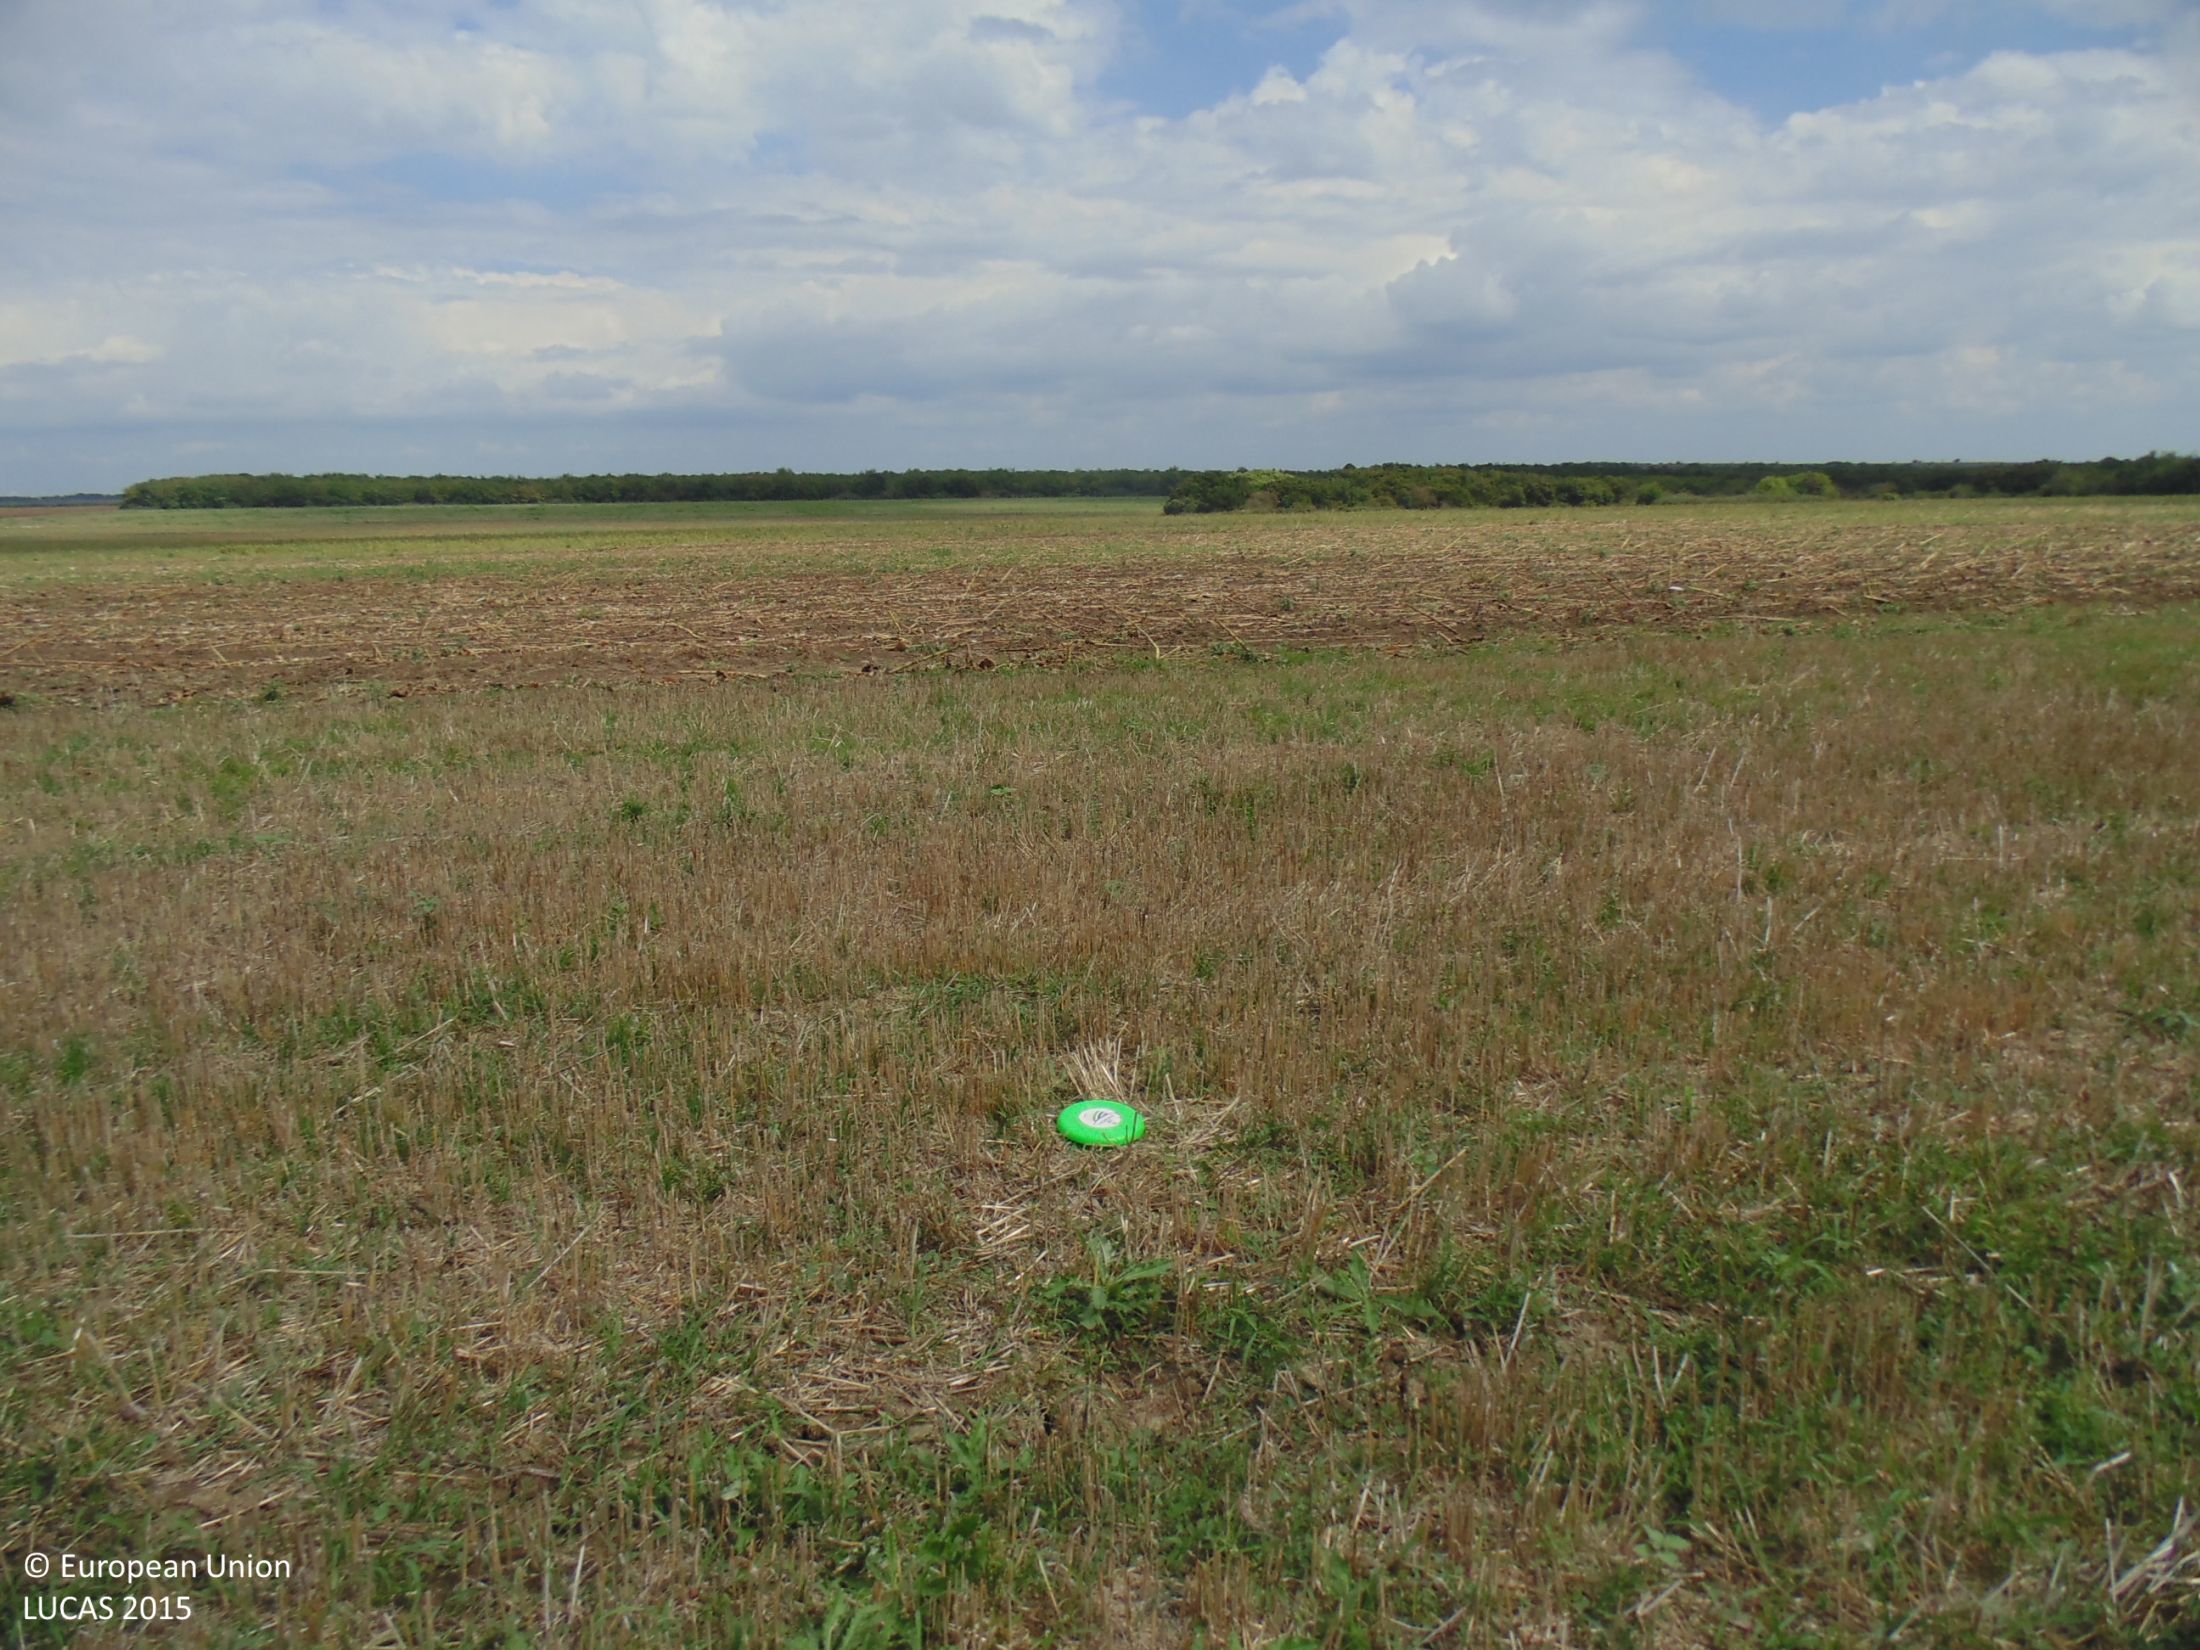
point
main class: Cropland
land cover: Common wheat
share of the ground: 25 - 50 %
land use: Agriculture (excluding fallow land and kitchen gardens)
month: September
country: BG
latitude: 43.4127
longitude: 28.4736
